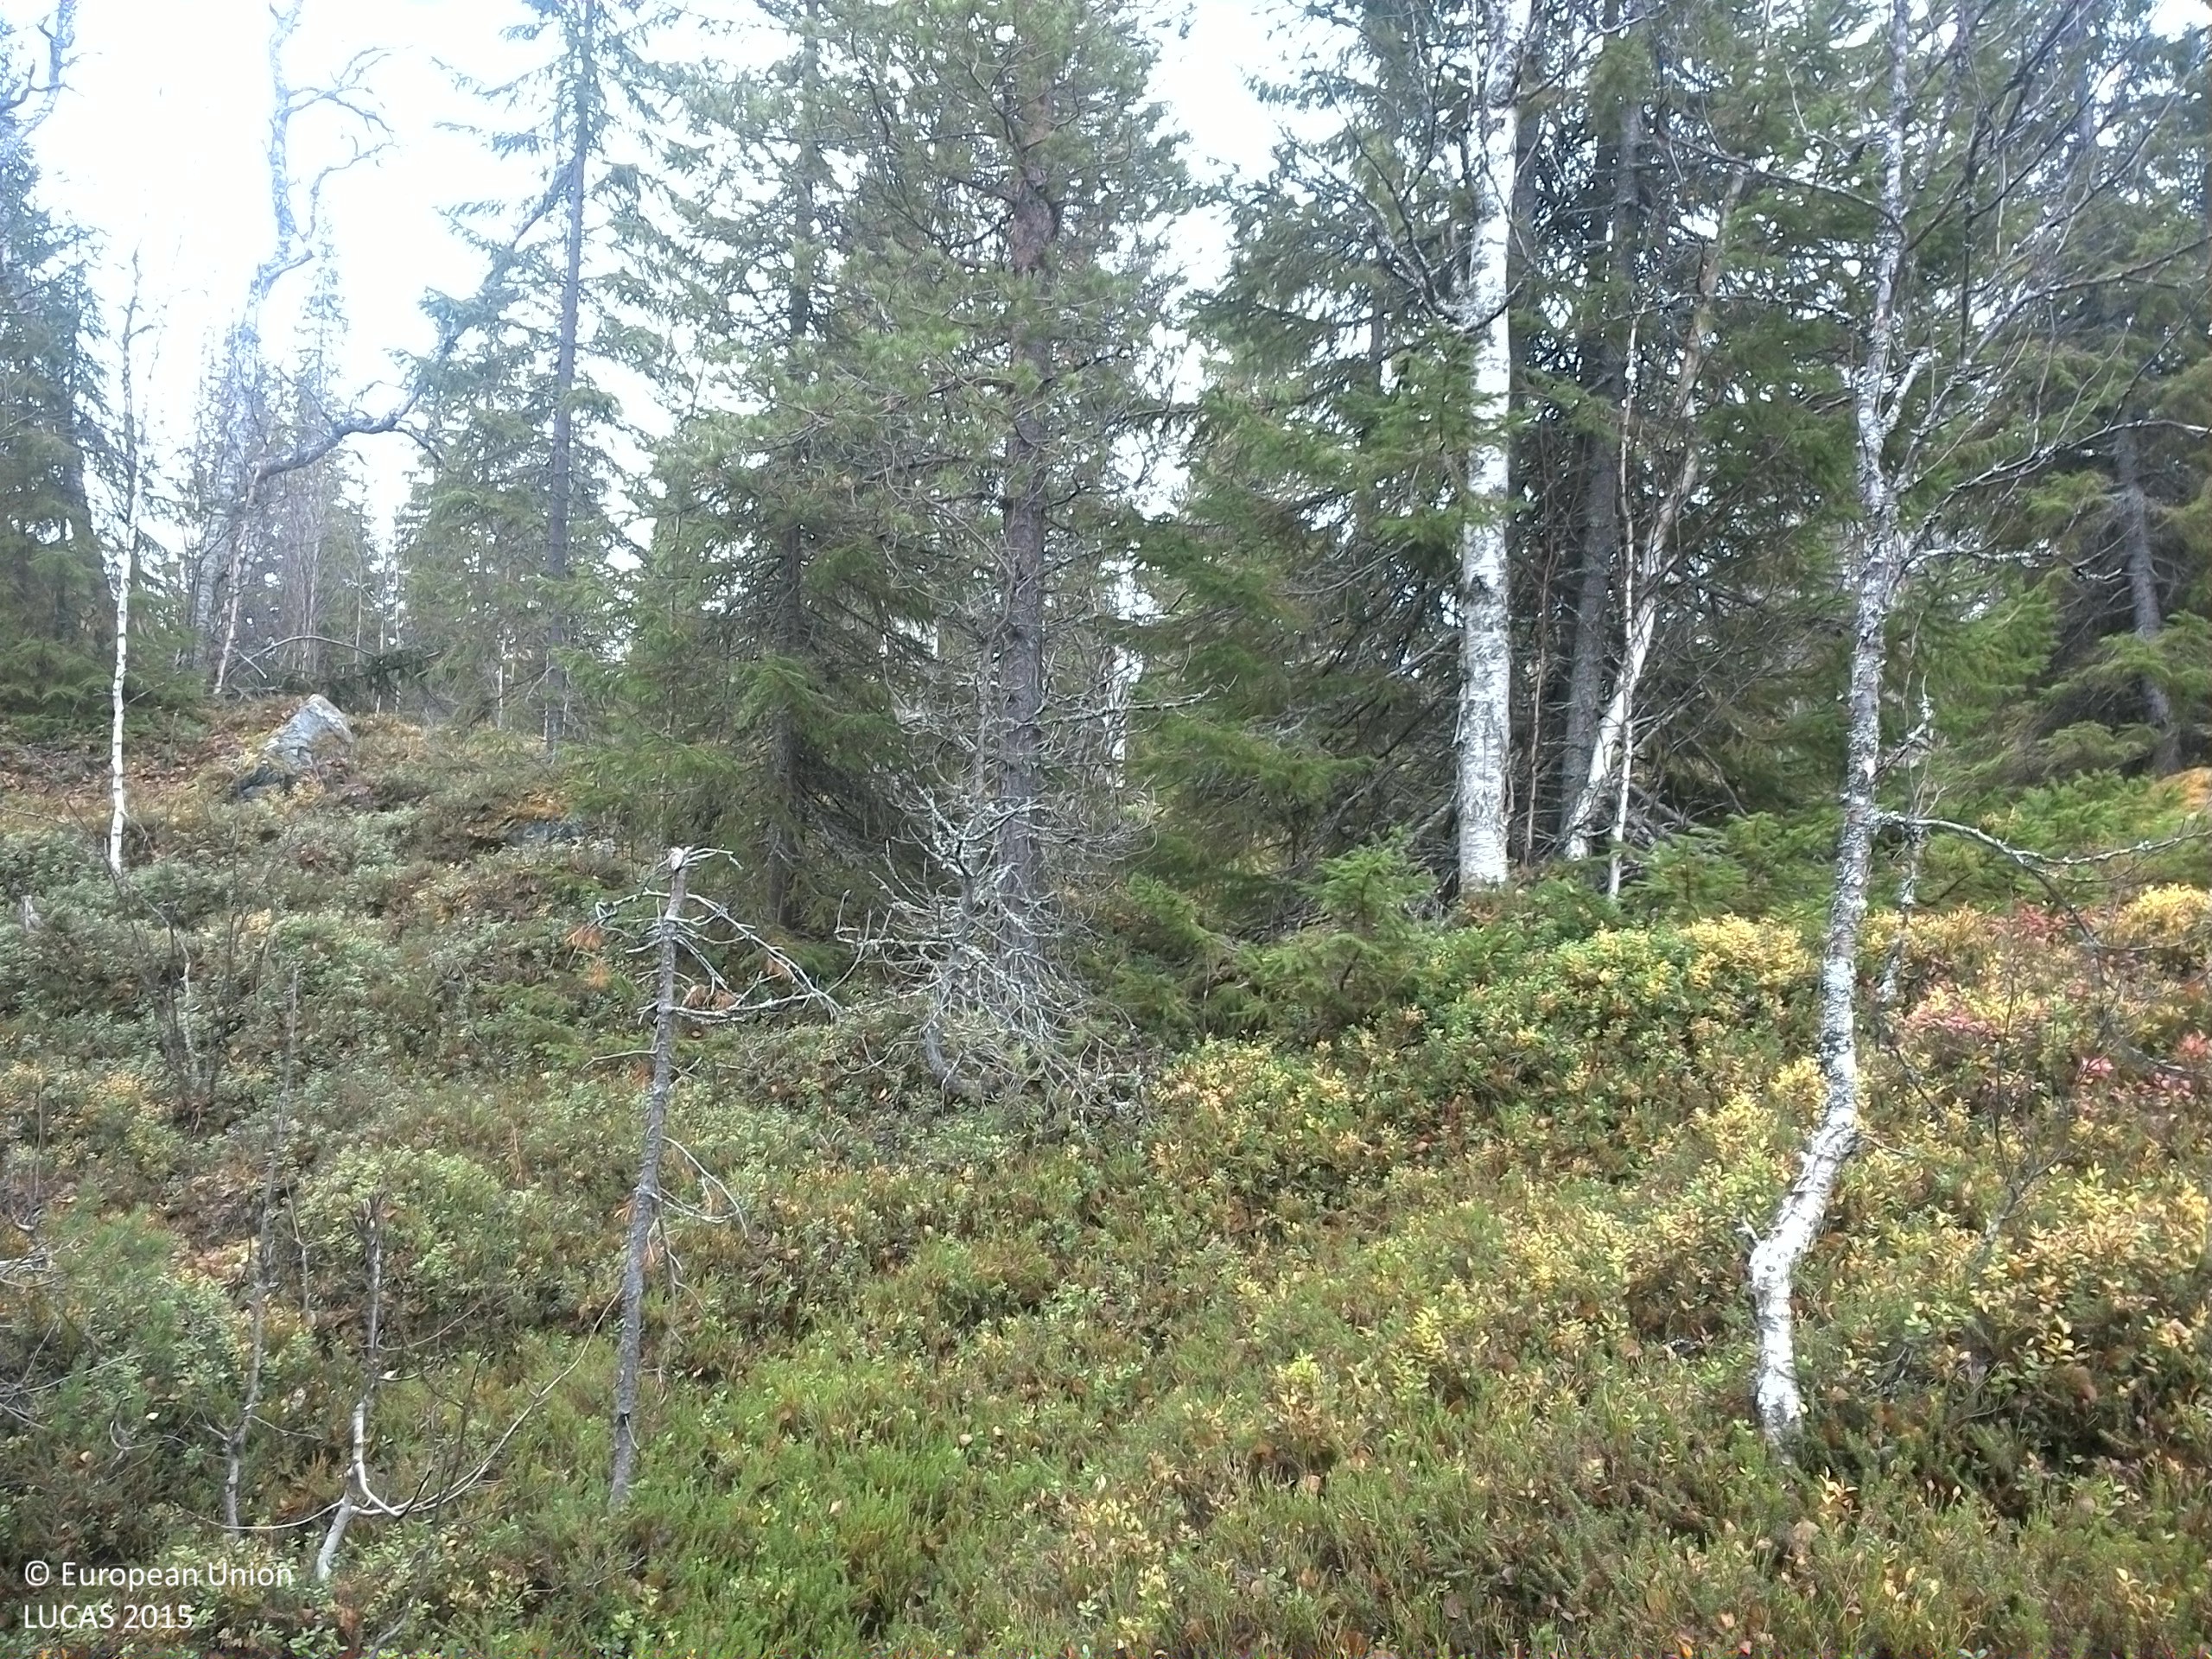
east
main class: Woodland
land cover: Spruce dominated mixed woodland
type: boreal forest
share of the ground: 25 - 50 %
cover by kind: shrubs 50 %, coniferous forest trees 20 %, broadleaved forest trees 20 %, lichens and mosses 10 %
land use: Forestry
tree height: > 5 m
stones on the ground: 25 - 50 %
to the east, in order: Spruce dominated mixed woodland; Inland marshes; Inland fresh water bodies; Inland marshes
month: October
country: SE
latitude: 64.4169
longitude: 14.7675
